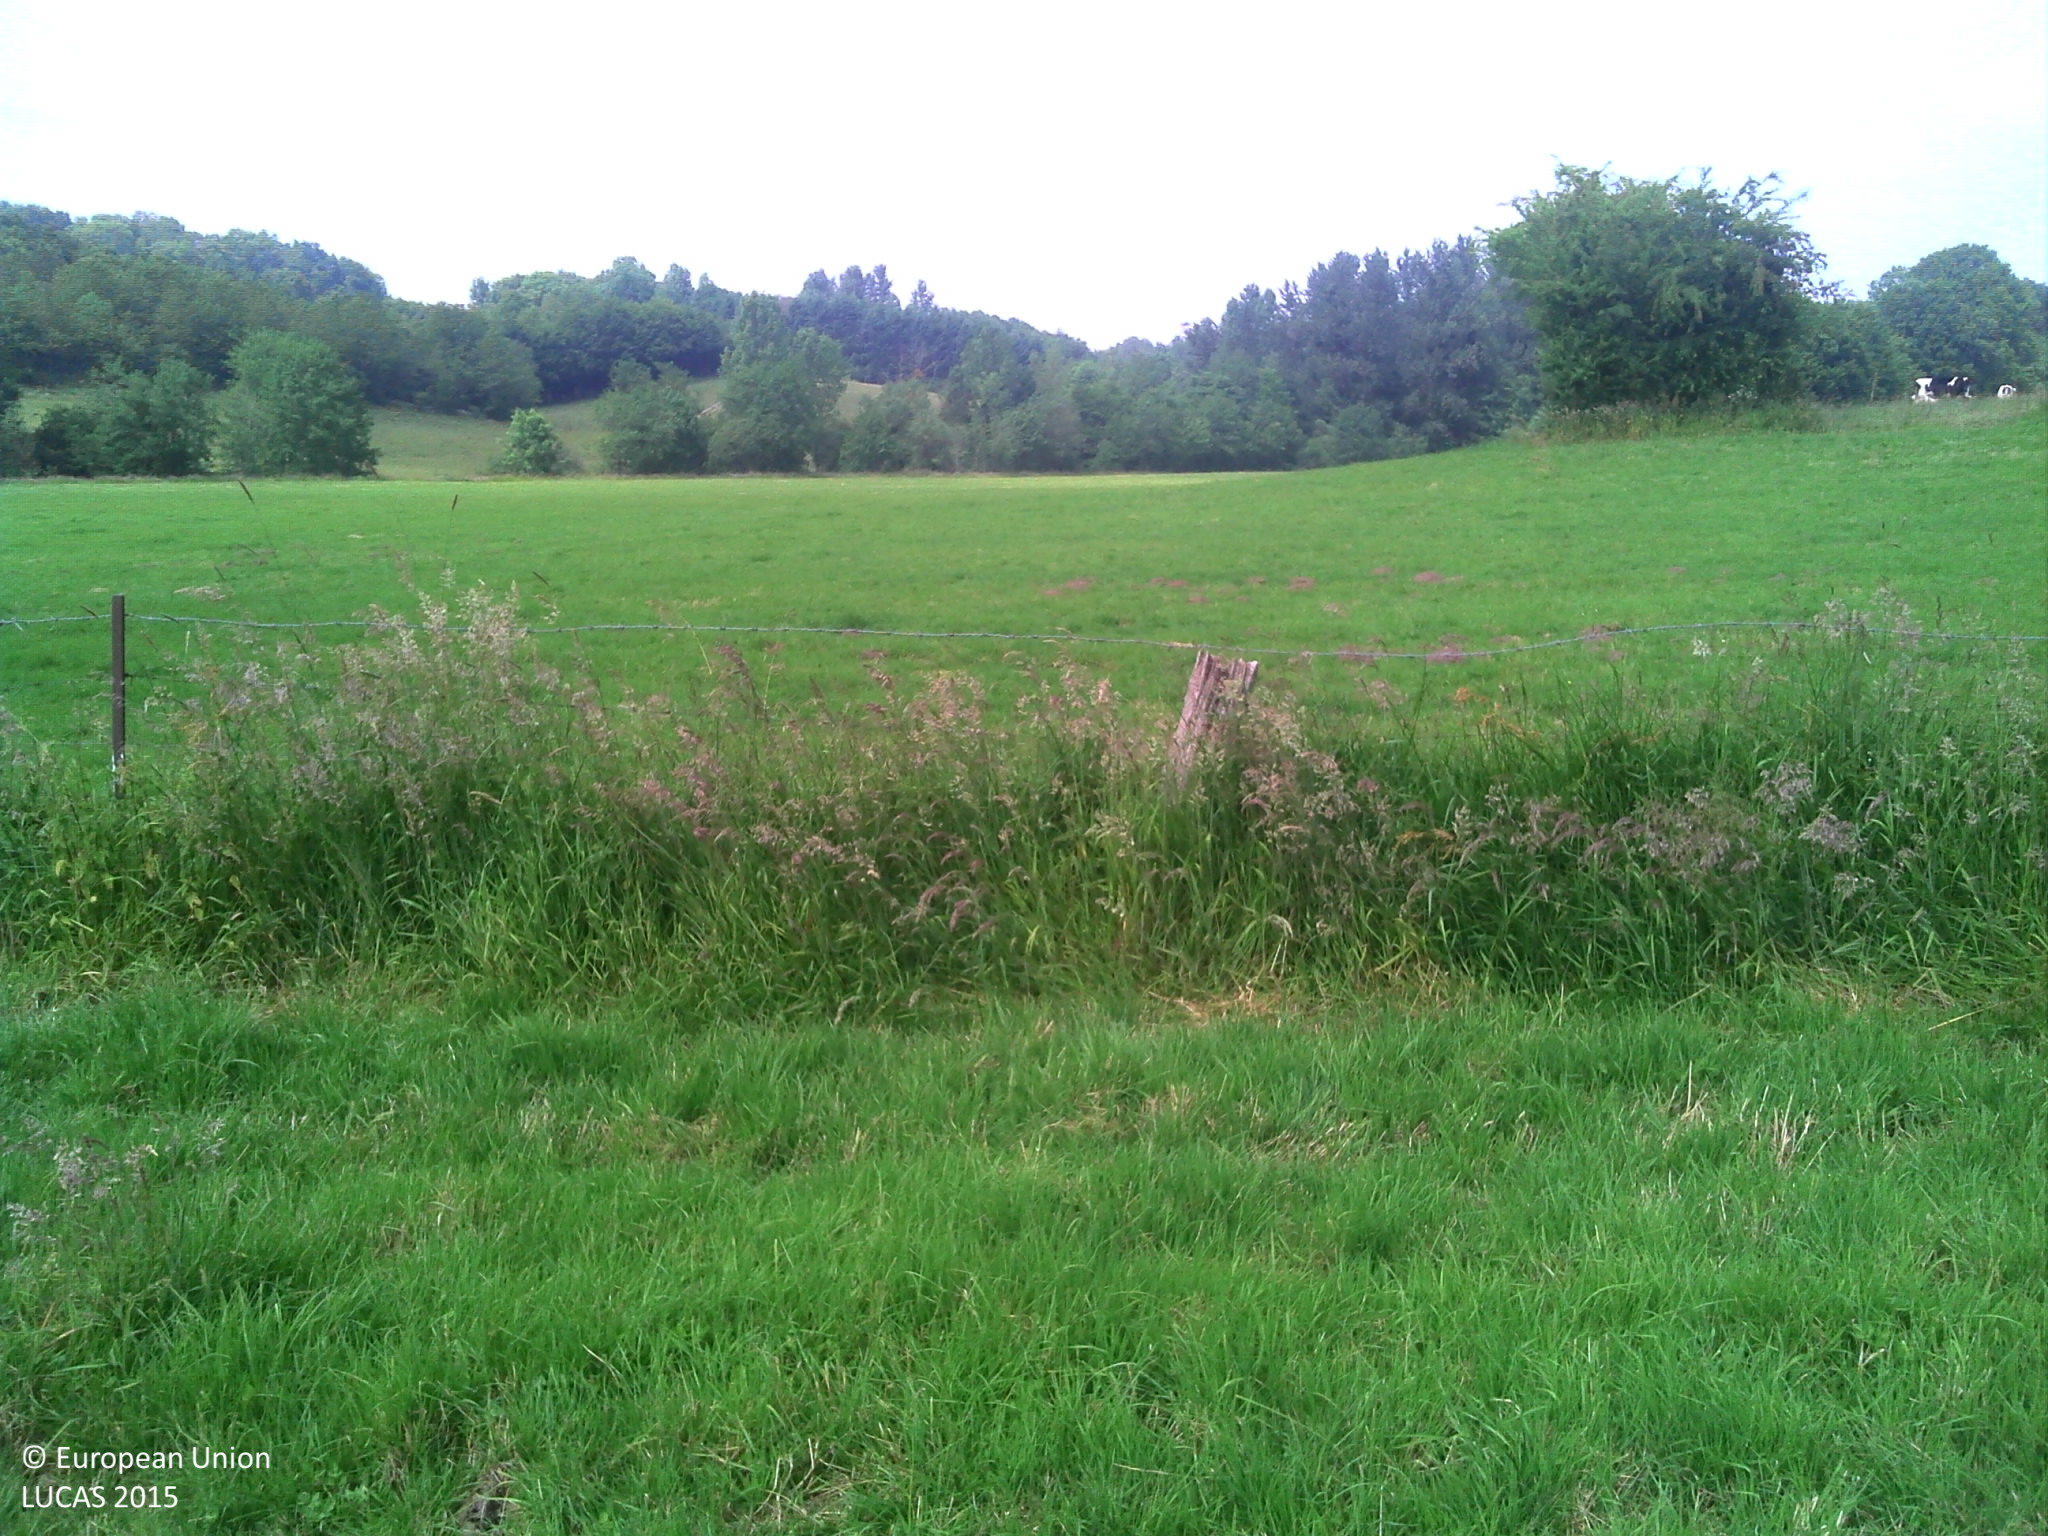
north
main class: Grassland
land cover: Grassland without tree/shrub cover
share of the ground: > 75 %
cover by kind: herbaceous plants 100 %
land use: Agriculture (excluding fallow land and kitchen gardens)
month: June
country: FR
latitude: 49.9370
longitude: 4.0173
